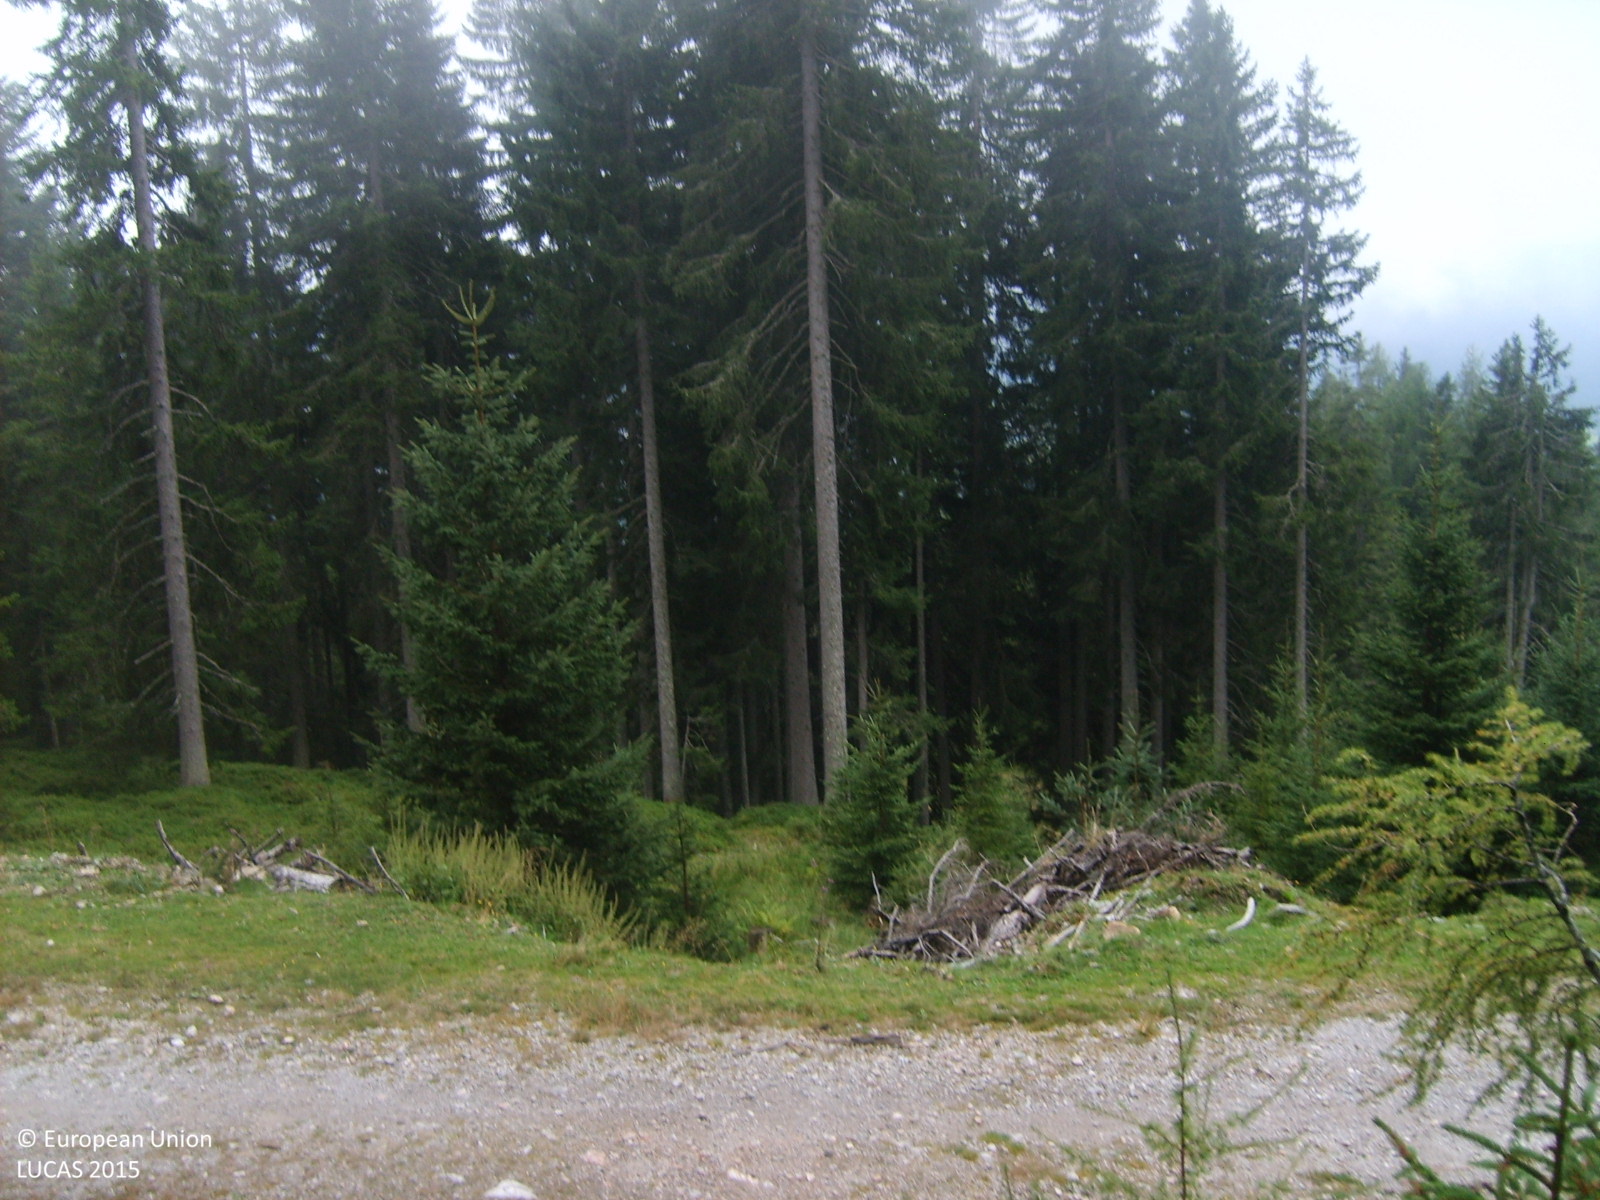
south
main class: Woodland
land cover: Spruce dominated coniferous woodland
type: alpine coniferous forest
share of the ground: > 75 %
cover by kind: coniferous forest trees 85 %, shrubs 10 %, herbaceous plants 5 %
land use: Forestry
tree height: > 5 m
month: September
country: AT
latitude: 47.4111
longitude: 13.5103
